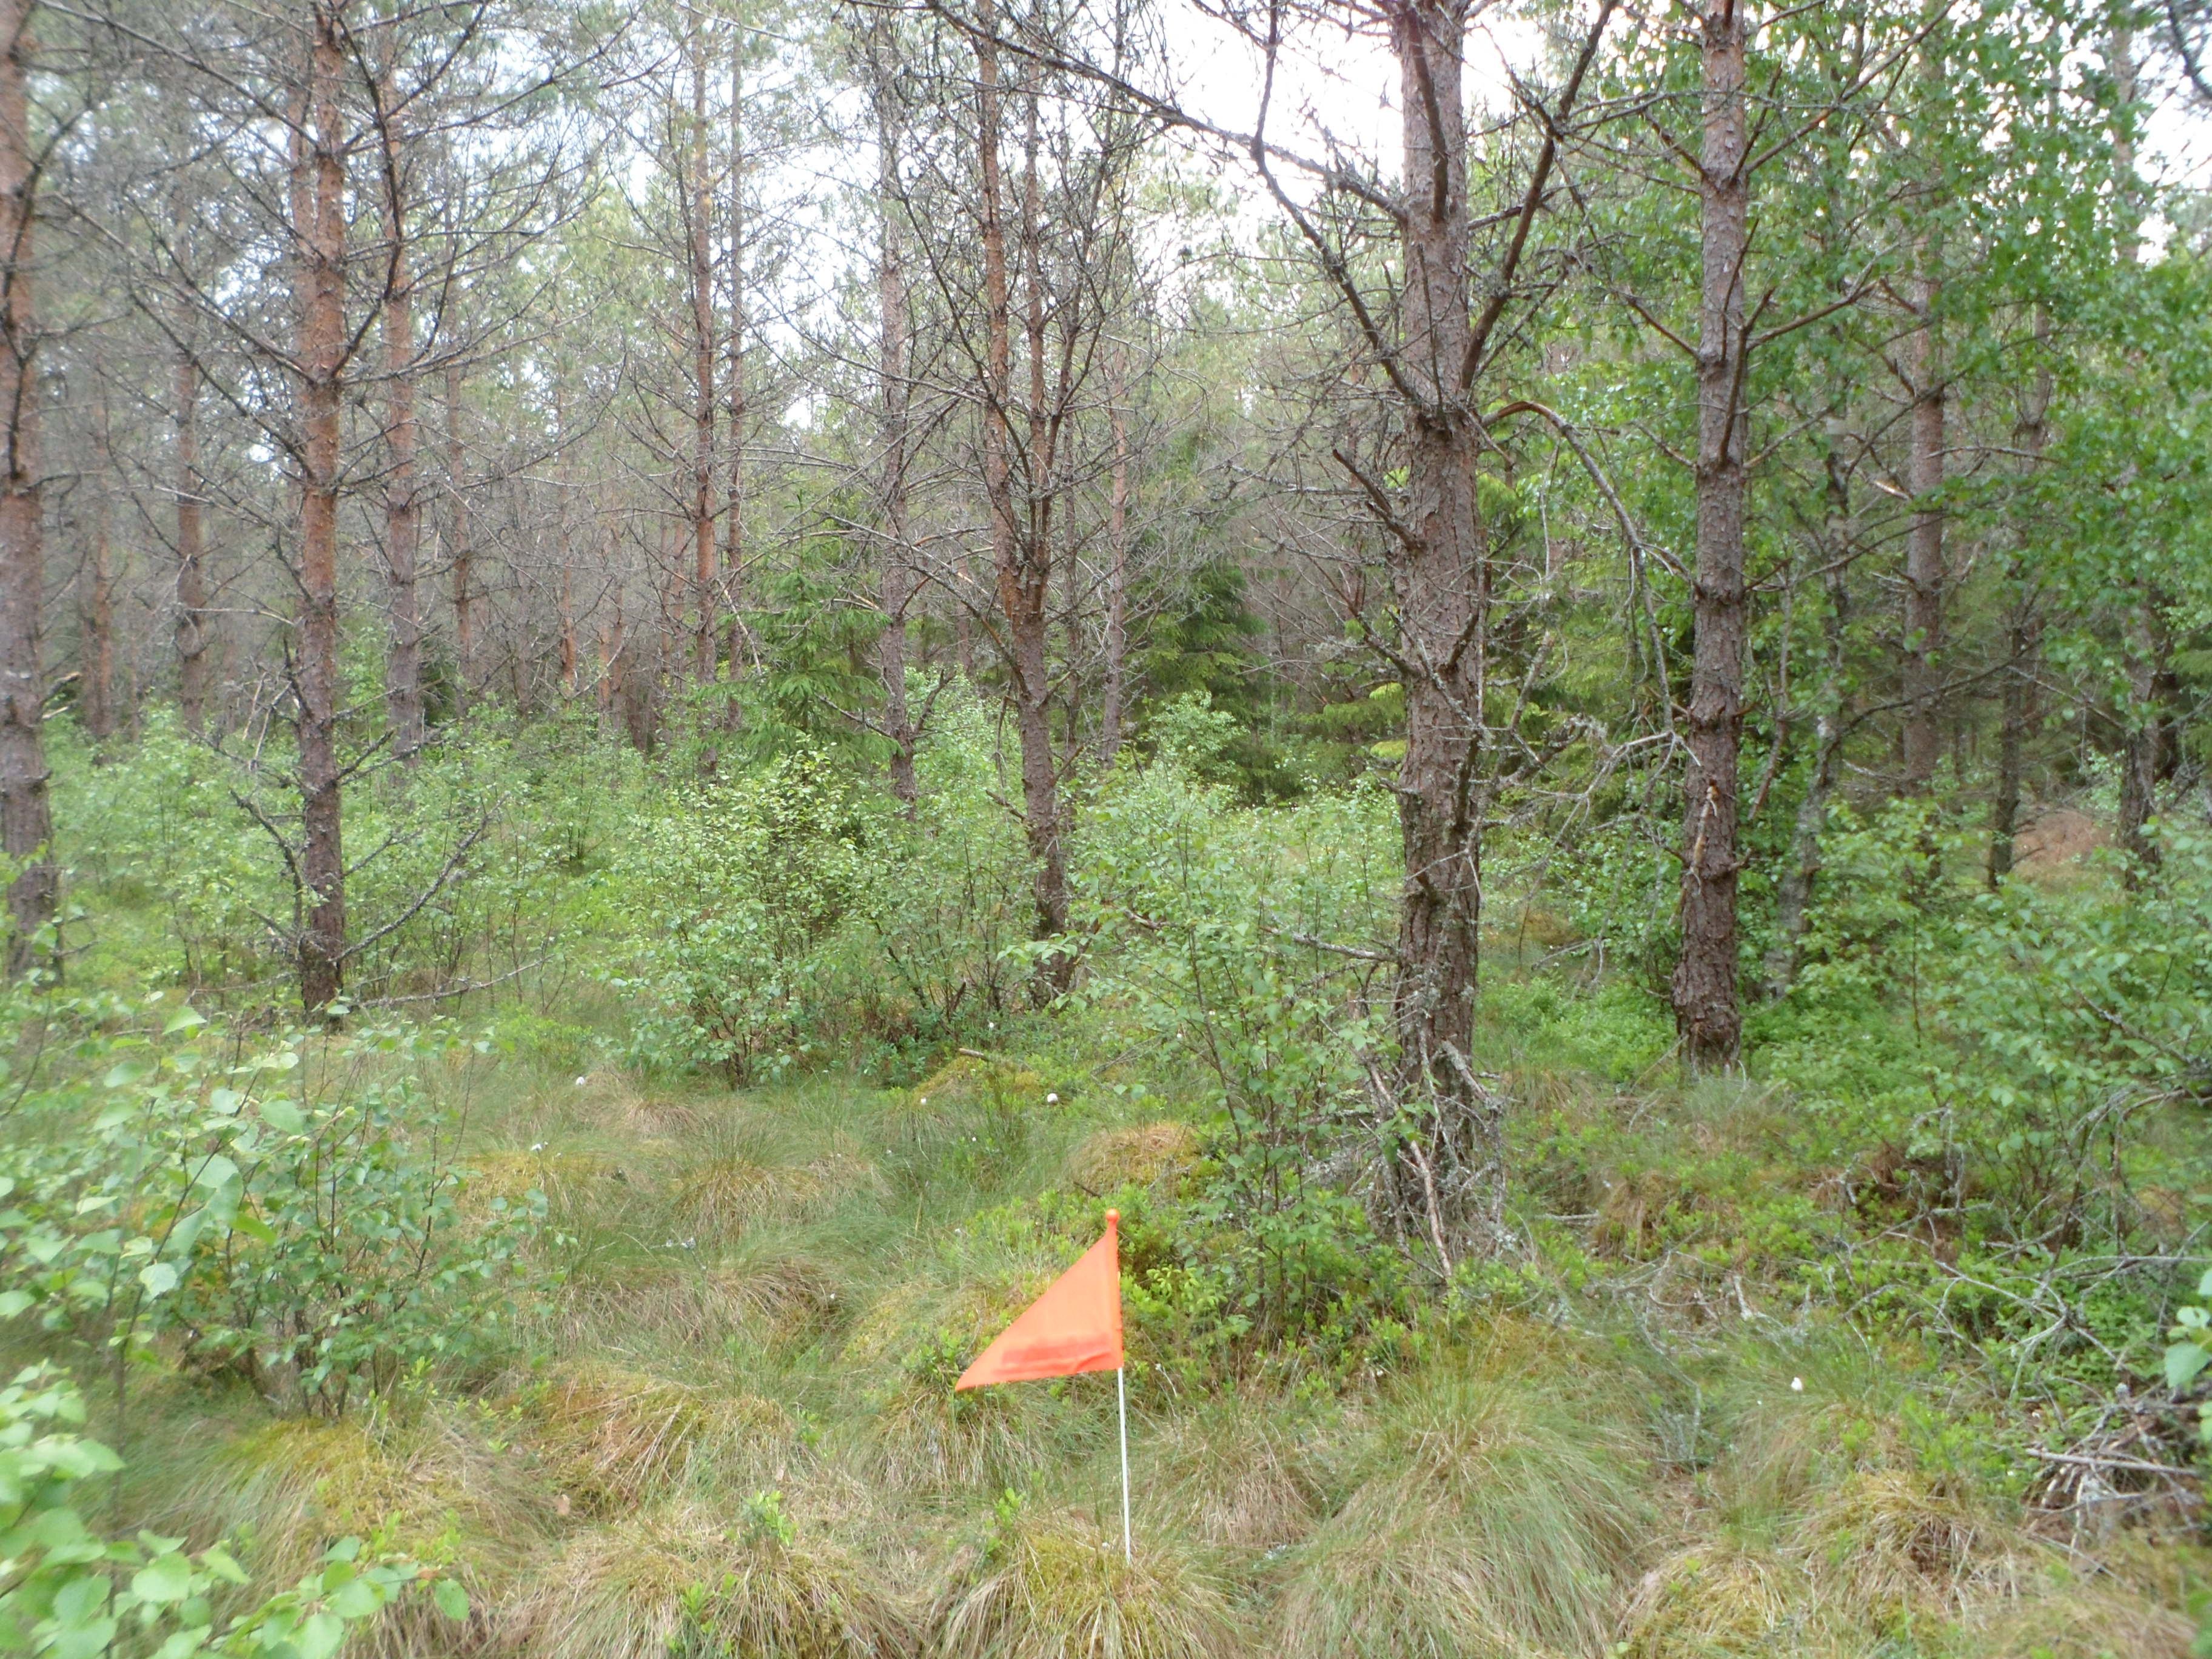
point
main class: Woodland
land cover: Pine dominated coniferous woodland
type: boreal forest
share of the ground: 50 - 75 %
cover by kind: coniferous forest trees 55 %, herbaceous plants 20 %, broadleaved forest trees 10 %, shrubs 10 %, lichens and mosses 5 %
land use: Forestry
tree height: > 5 m
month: June
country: SE
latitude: 56.9738
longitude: 14.4878
